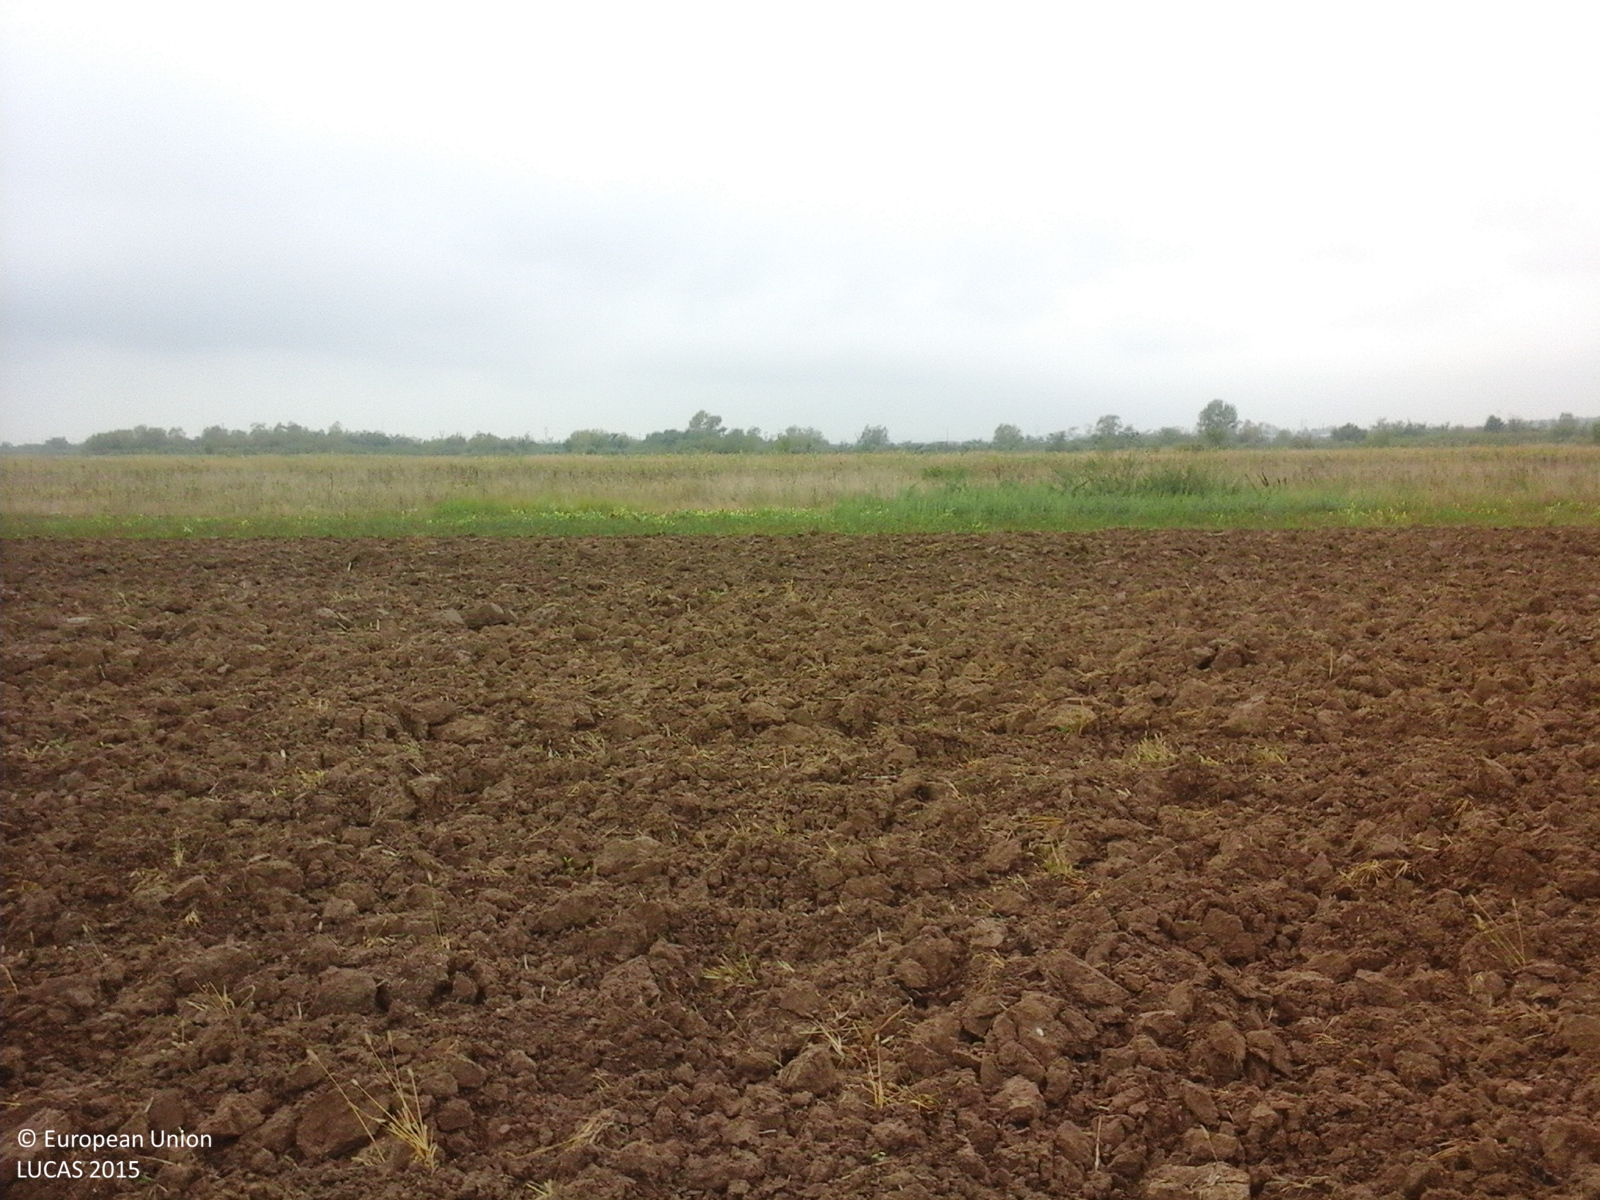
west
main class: Grassland
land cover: Grassland with sparse tree/shrub cover
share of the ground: > 75 %
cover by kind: herbaceous plants 95 %, broadleaved forest trees 5 %
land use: Agriculture (excluding fallow land and kitchen gardens)
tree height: < 5 m
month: September
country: RO
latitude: 45.0360
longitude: 23.3454
